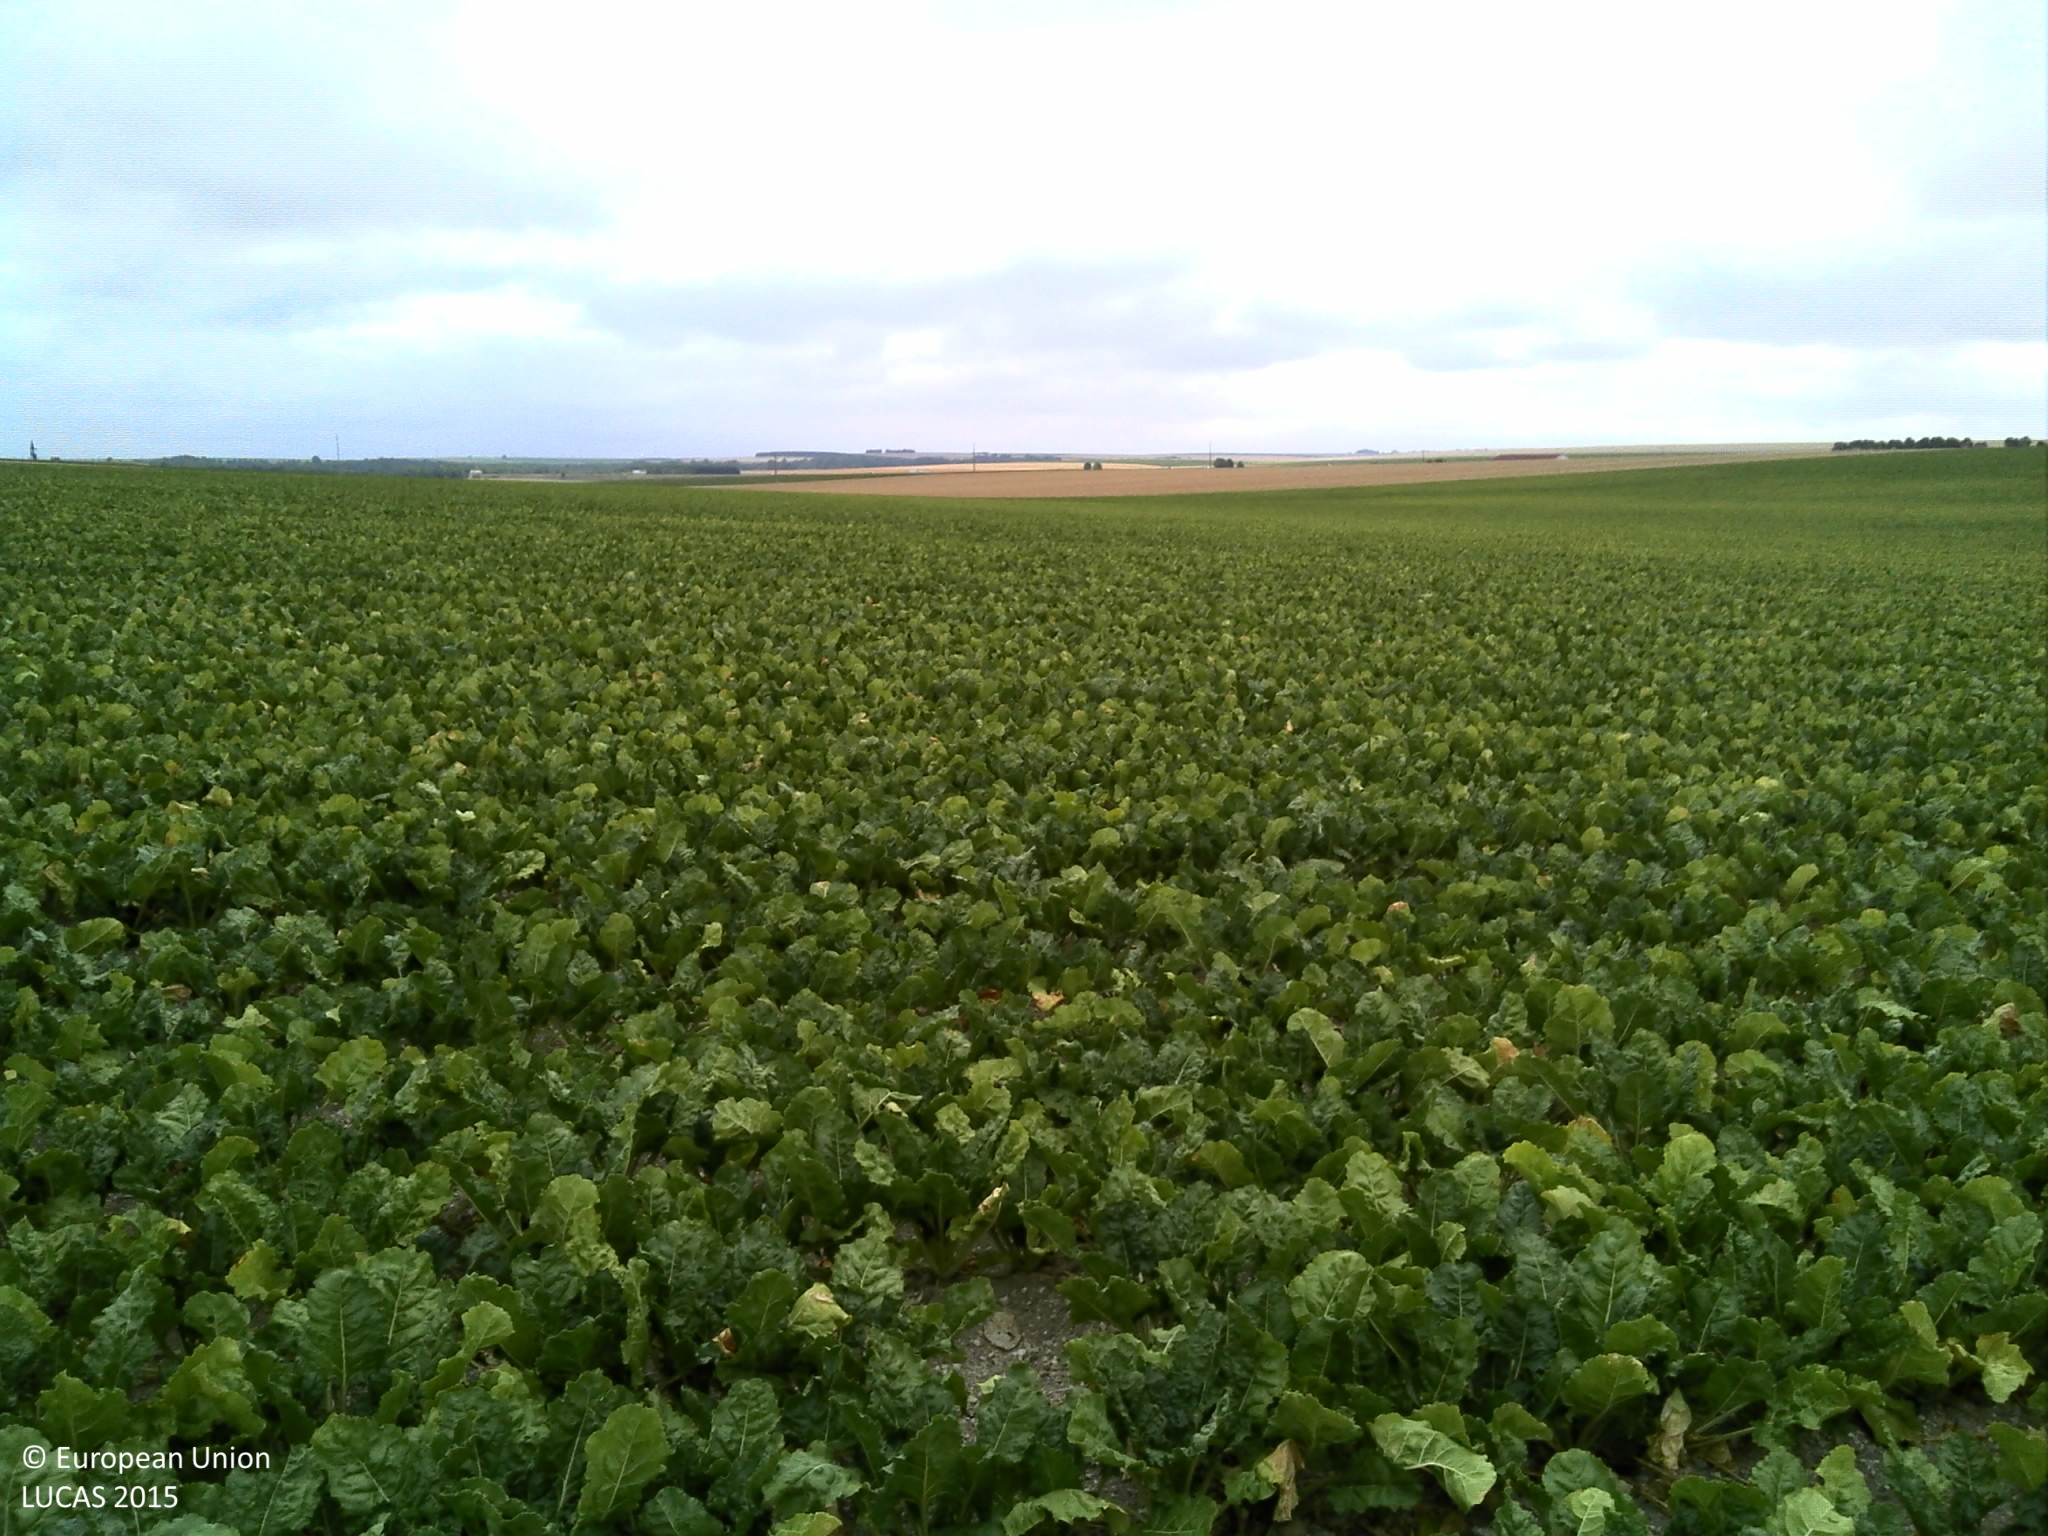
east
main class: Cropland
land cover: Sugar beet
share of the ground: 50 - 75 %
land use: Agriculture (excluding fallow land and kitchen gardens)
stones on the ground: < 10 %
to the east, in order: Sugar beet
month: August
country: FR
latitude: 48.7764
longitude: 4.2400
